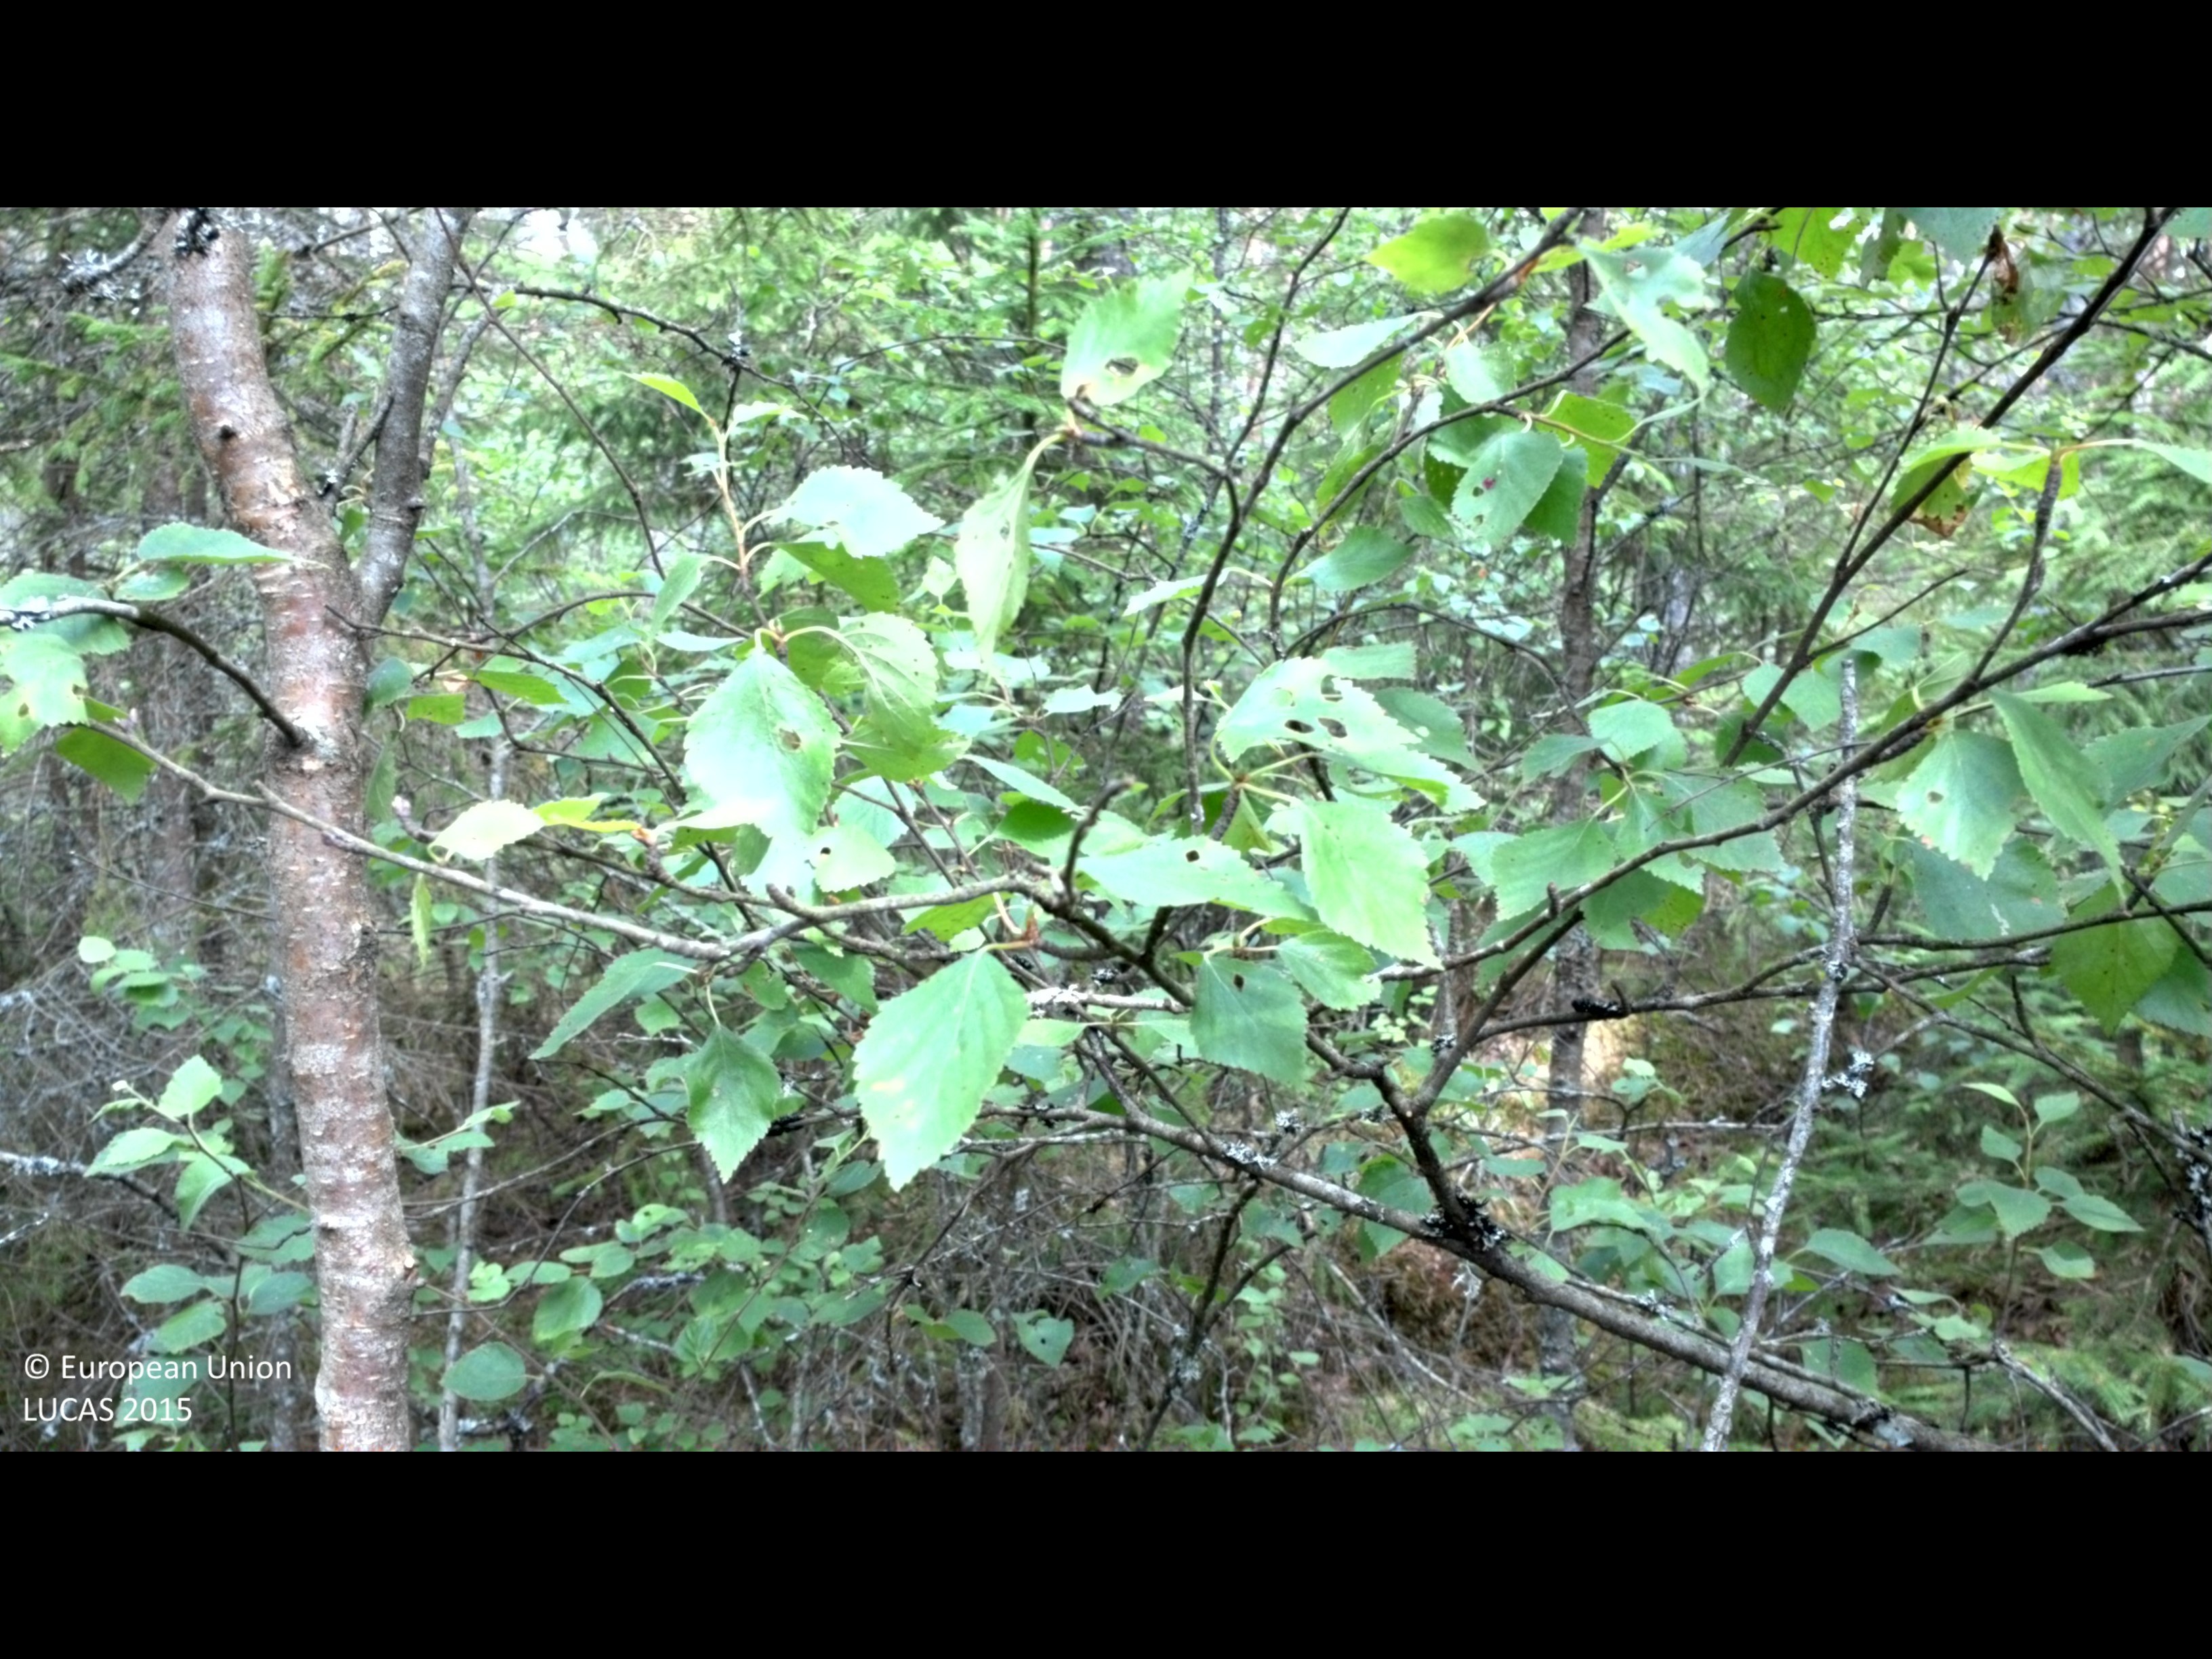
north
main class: Woodland
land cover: Other mixed woodland
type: boreal forest
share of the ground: > 75 %
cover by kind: coniferous forest trees 50 %, broadleaved forest trees 30 %, shrubs 15 %, lichens and mosses 5 %
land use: Forestry
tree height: > 5 m
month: July
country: SE
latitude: 56.4357
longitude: 14.4250
